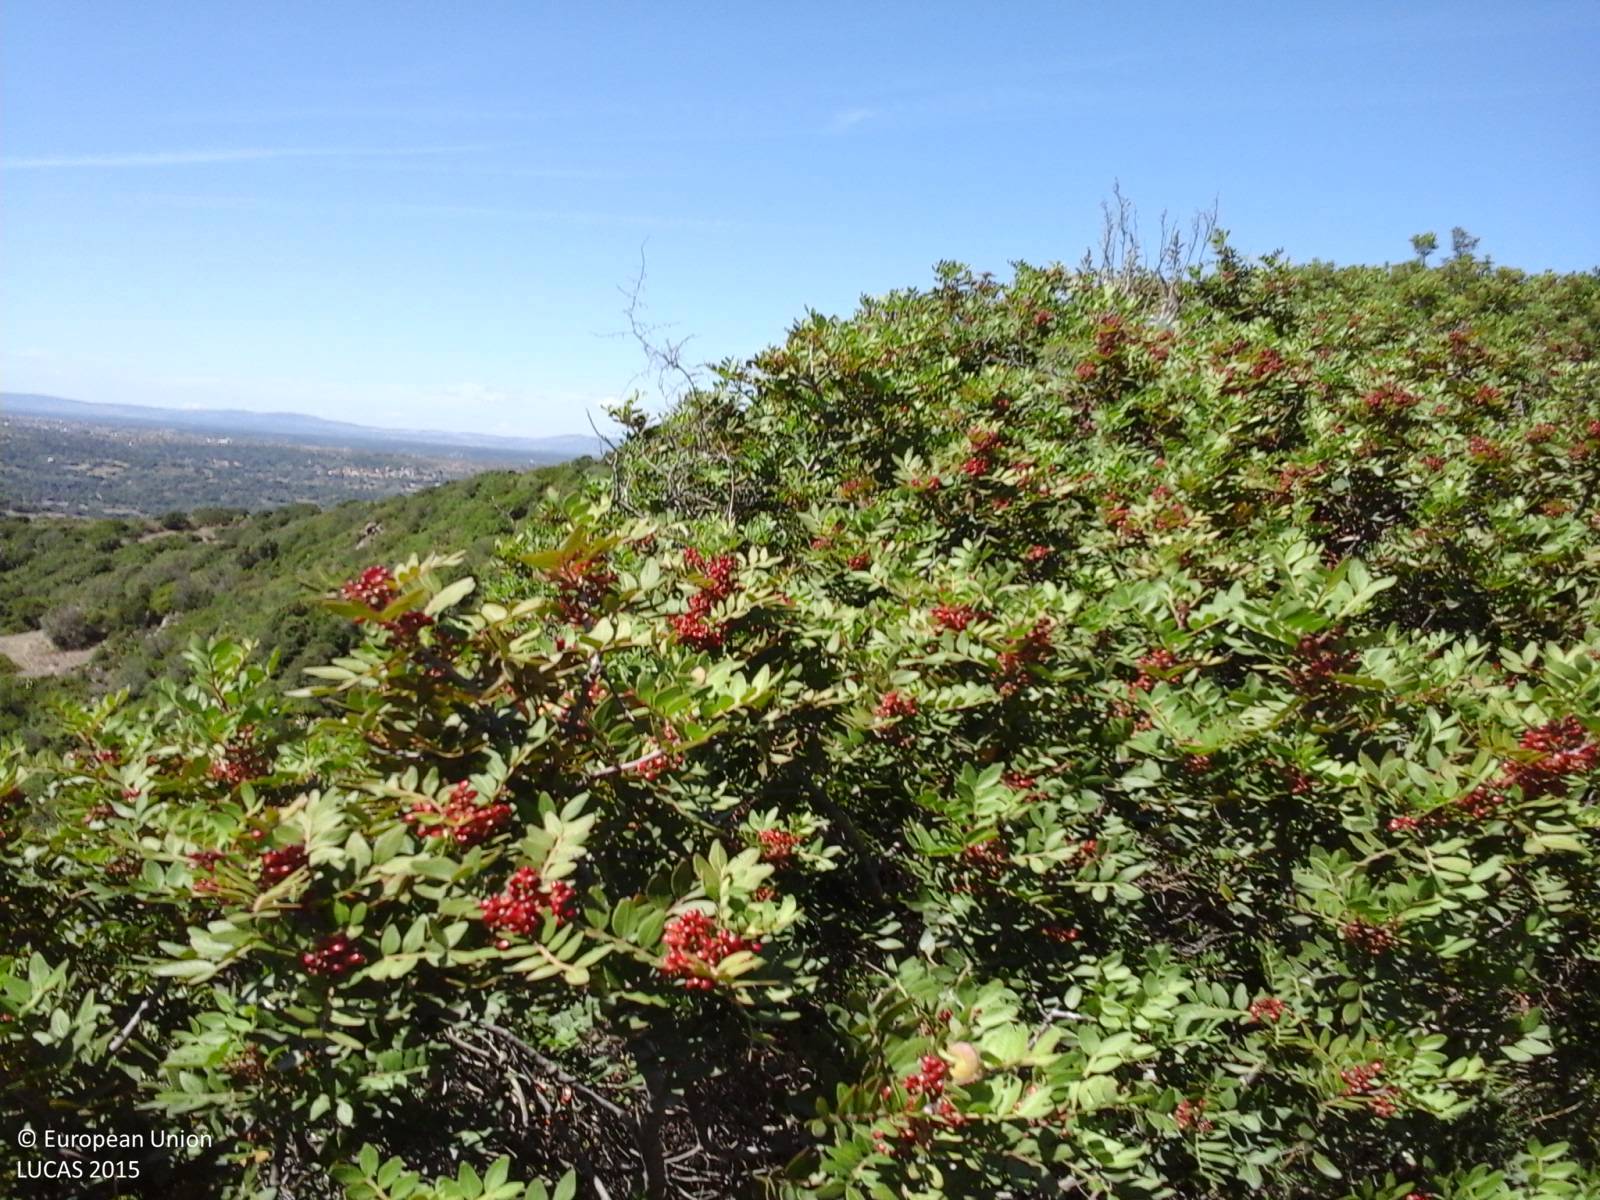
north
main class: Woodland
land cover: Broadleaved woodland
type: broadleaved evergreen forest
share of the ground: > 75 %
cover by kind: broadleaved forest trees 100 %
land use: Forestry
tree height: < 5 m
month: August
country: IT
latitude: 40.0800
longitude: 8.8919
